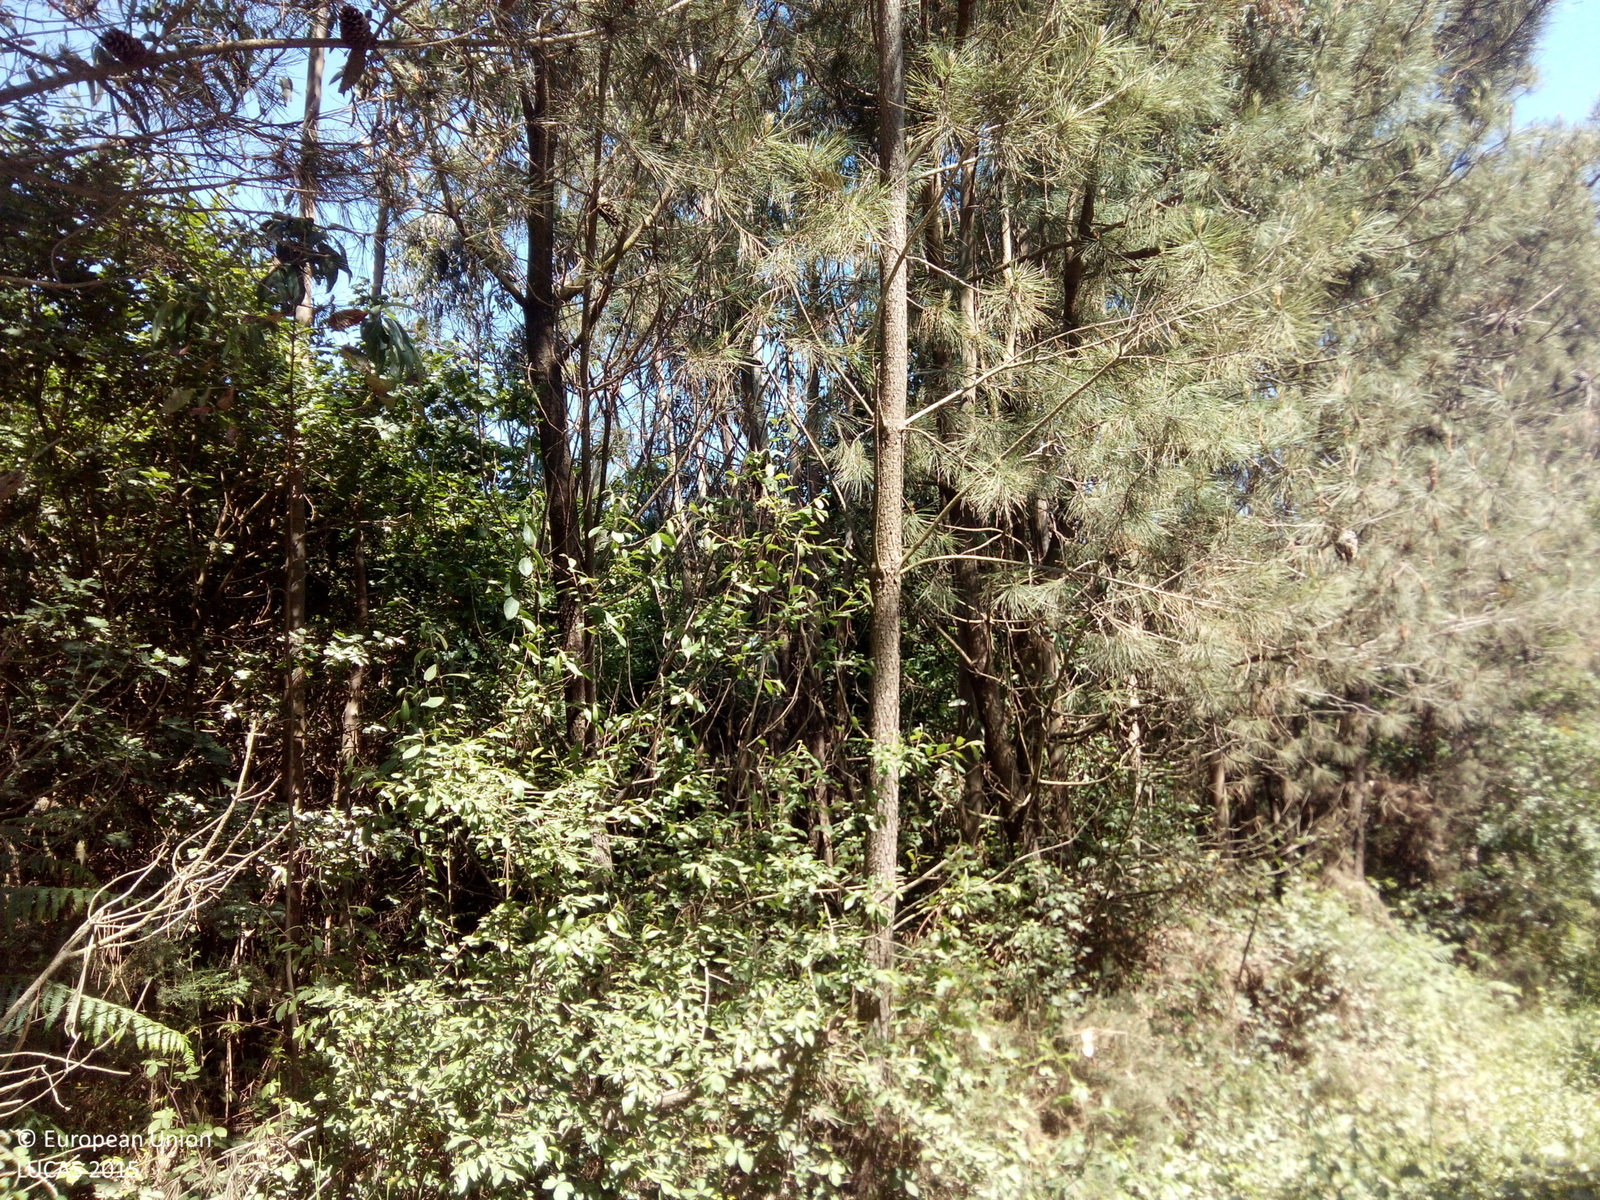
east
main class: Woodland
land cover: Pine dominated mixed woodland
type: hemiboreal forest and nemoral coniferous forest and mixed broadleaved-coniferous forest
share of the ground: > 75 %
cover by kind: coniferous forest trees 75 %, broadleaved forest trees 25 %
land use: Forestry
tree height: > 5 m
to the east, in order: Pine dominated mixed woodland; Pine dominated coniferous woodland; Broadleaved woodland; Grassland with sparse tree/shrub cover
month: May
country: ES
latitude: 42.7935
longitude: -8.4265
